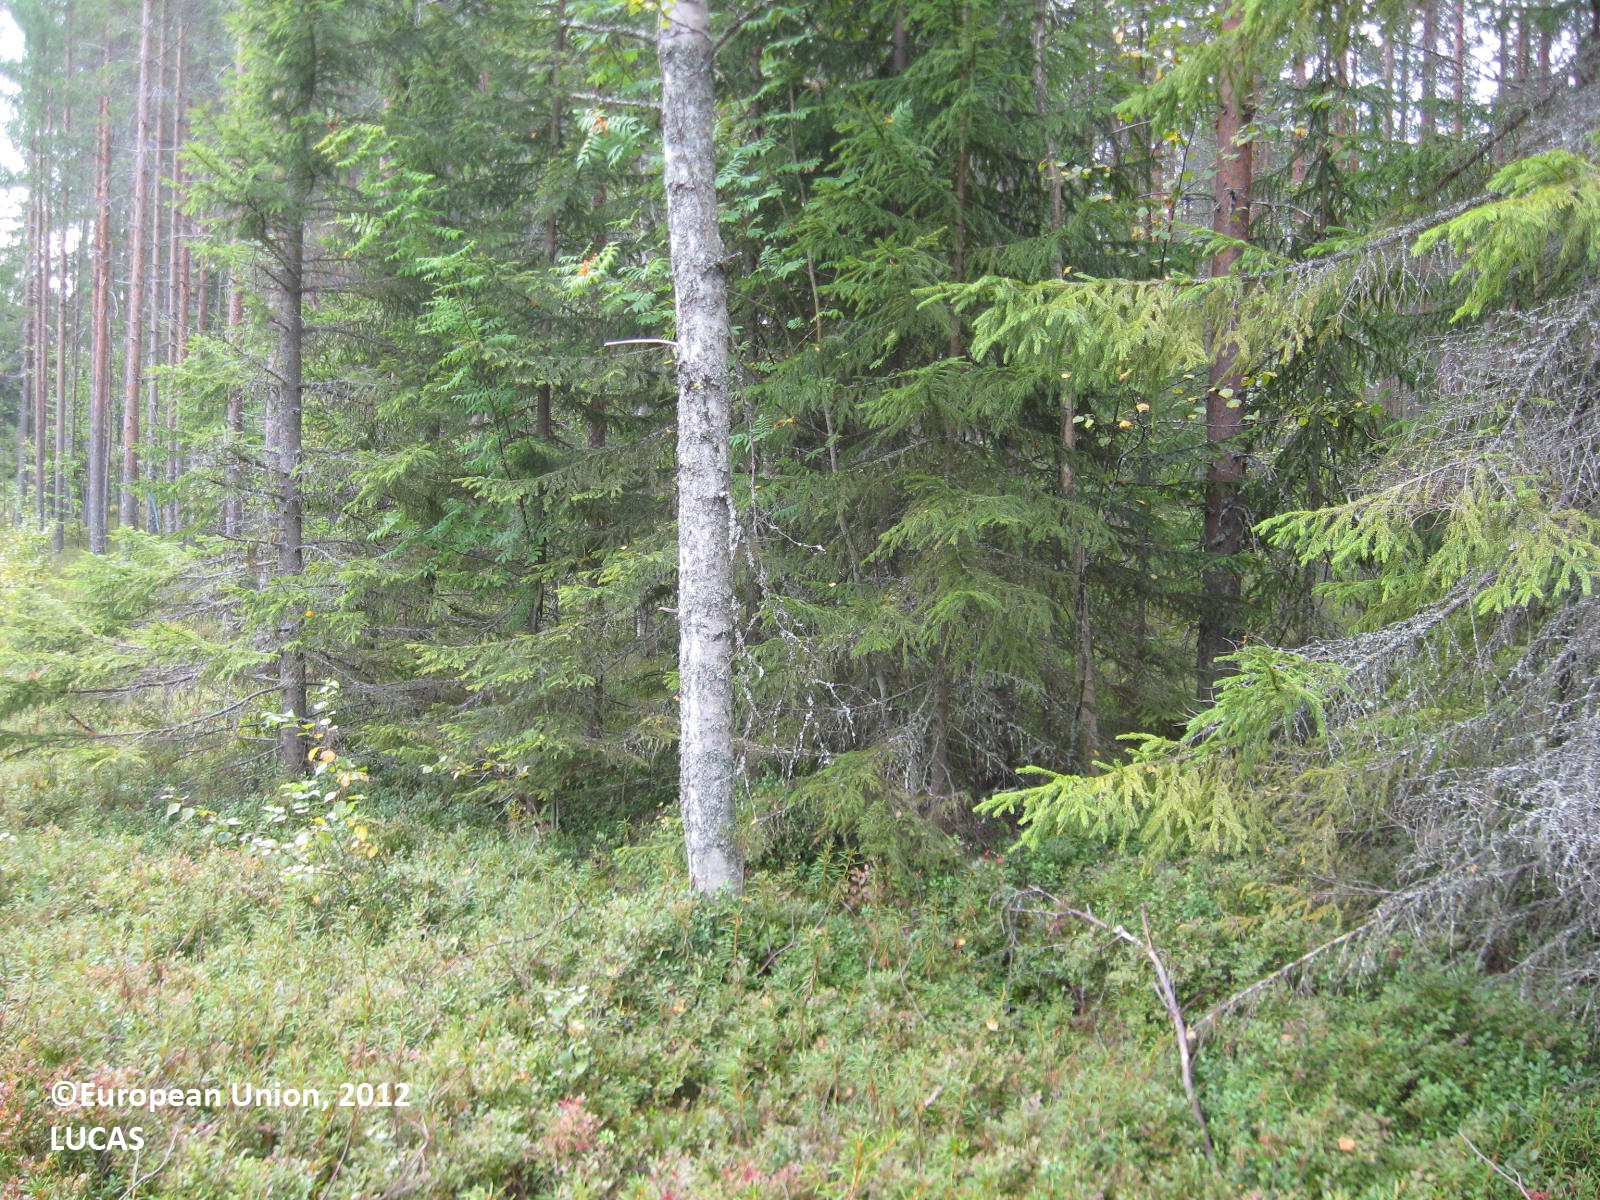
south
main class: Shrubland
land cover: Shrubland with sparse tree cover
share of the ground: > 75 %
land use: Energy production
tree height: < 5 m
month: August
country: FI
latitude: 63.4416
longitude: 29.4092
